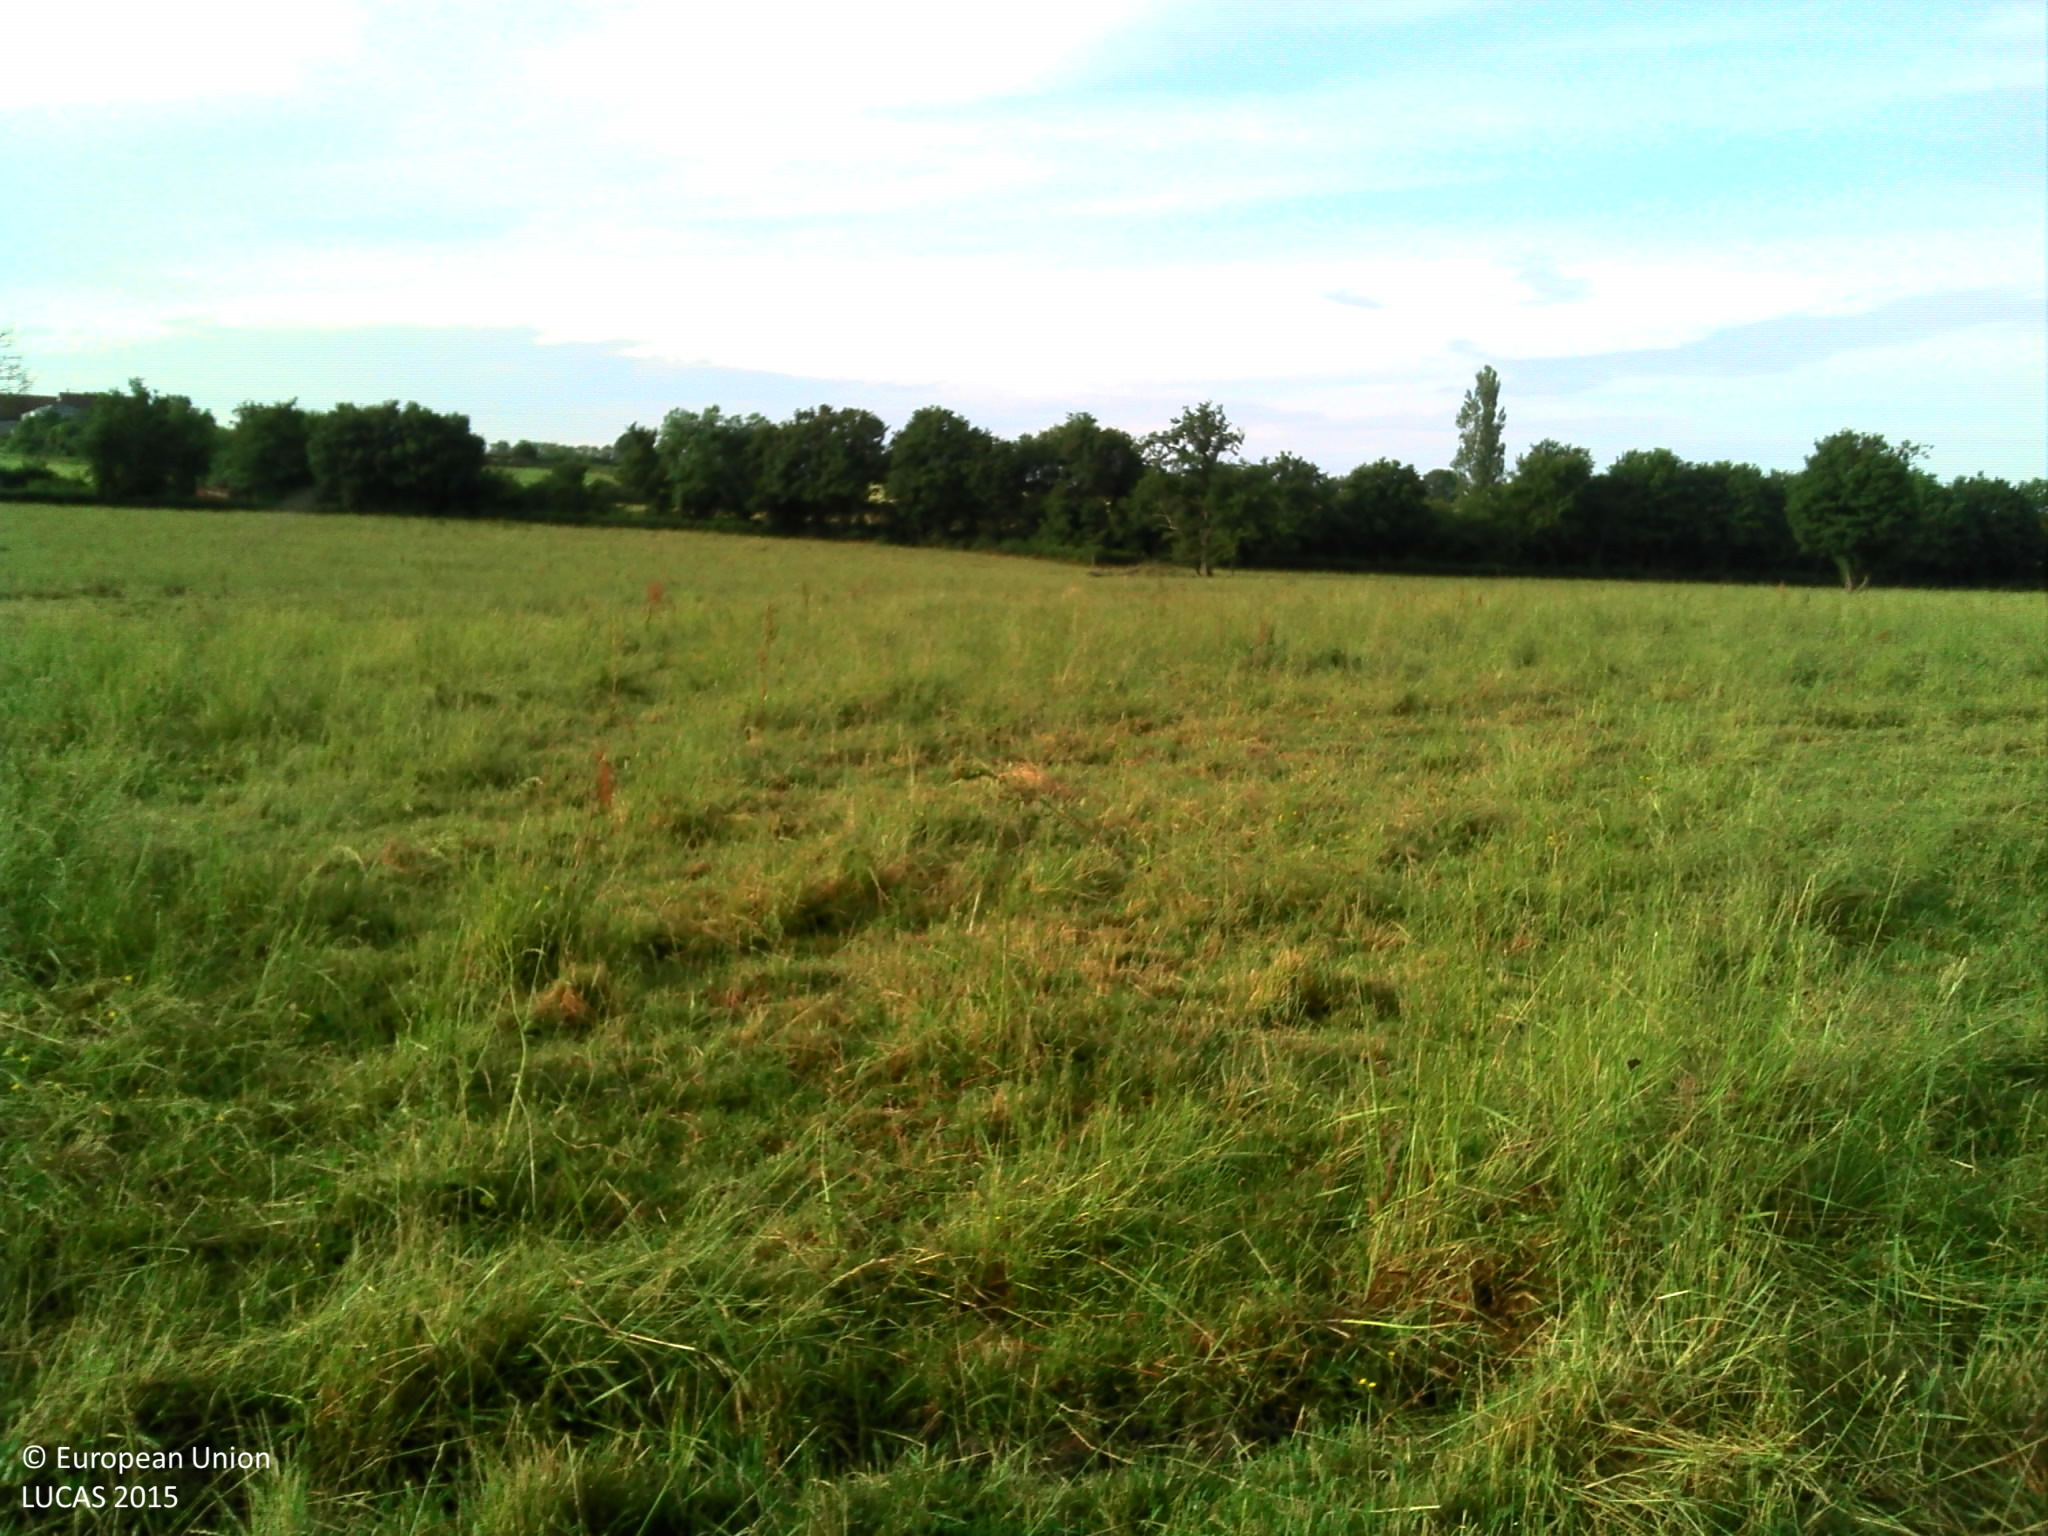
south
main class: Grassland
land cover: Grassland without tree/shrub cover
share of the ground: > 75 %
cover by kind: herbaceous plants 100 %
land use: Agriculture (excluding fallow land and kitchen gardens)
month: June
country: FR
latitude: 46.7151
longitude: 2.6824
